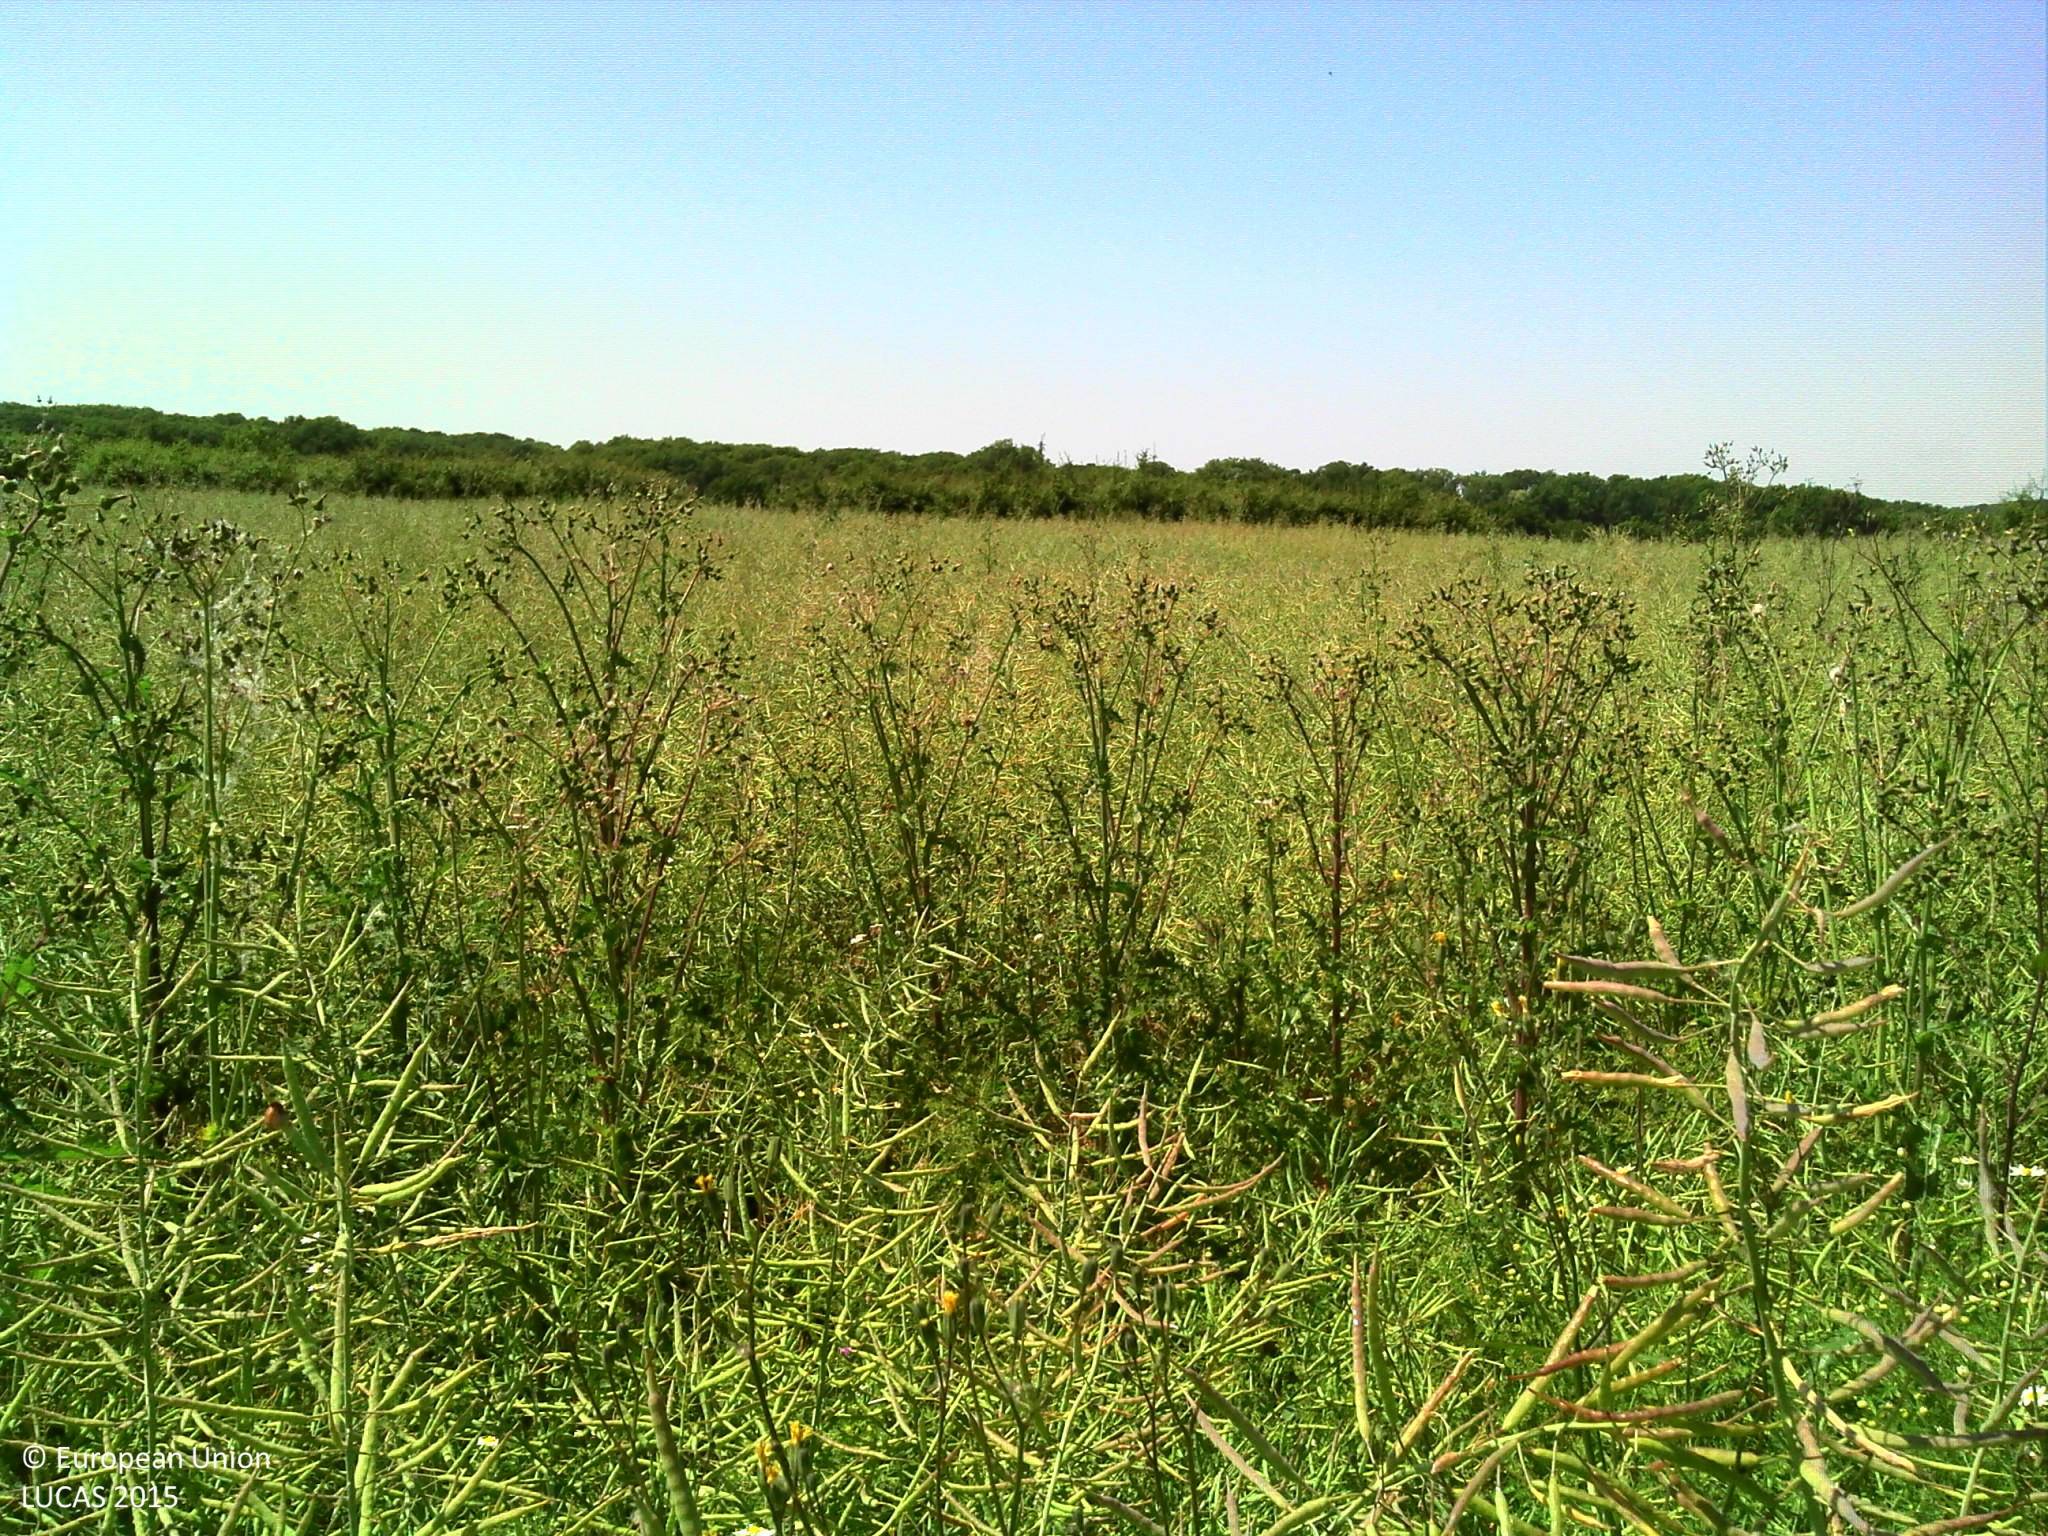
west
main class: Cropland
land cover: Rape and turnip rape
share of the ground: > 75 %
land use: Agriculture (excluding fallow land and kitchen gardens)
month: June
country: FR
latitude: 46.9030
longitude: 2.7881
